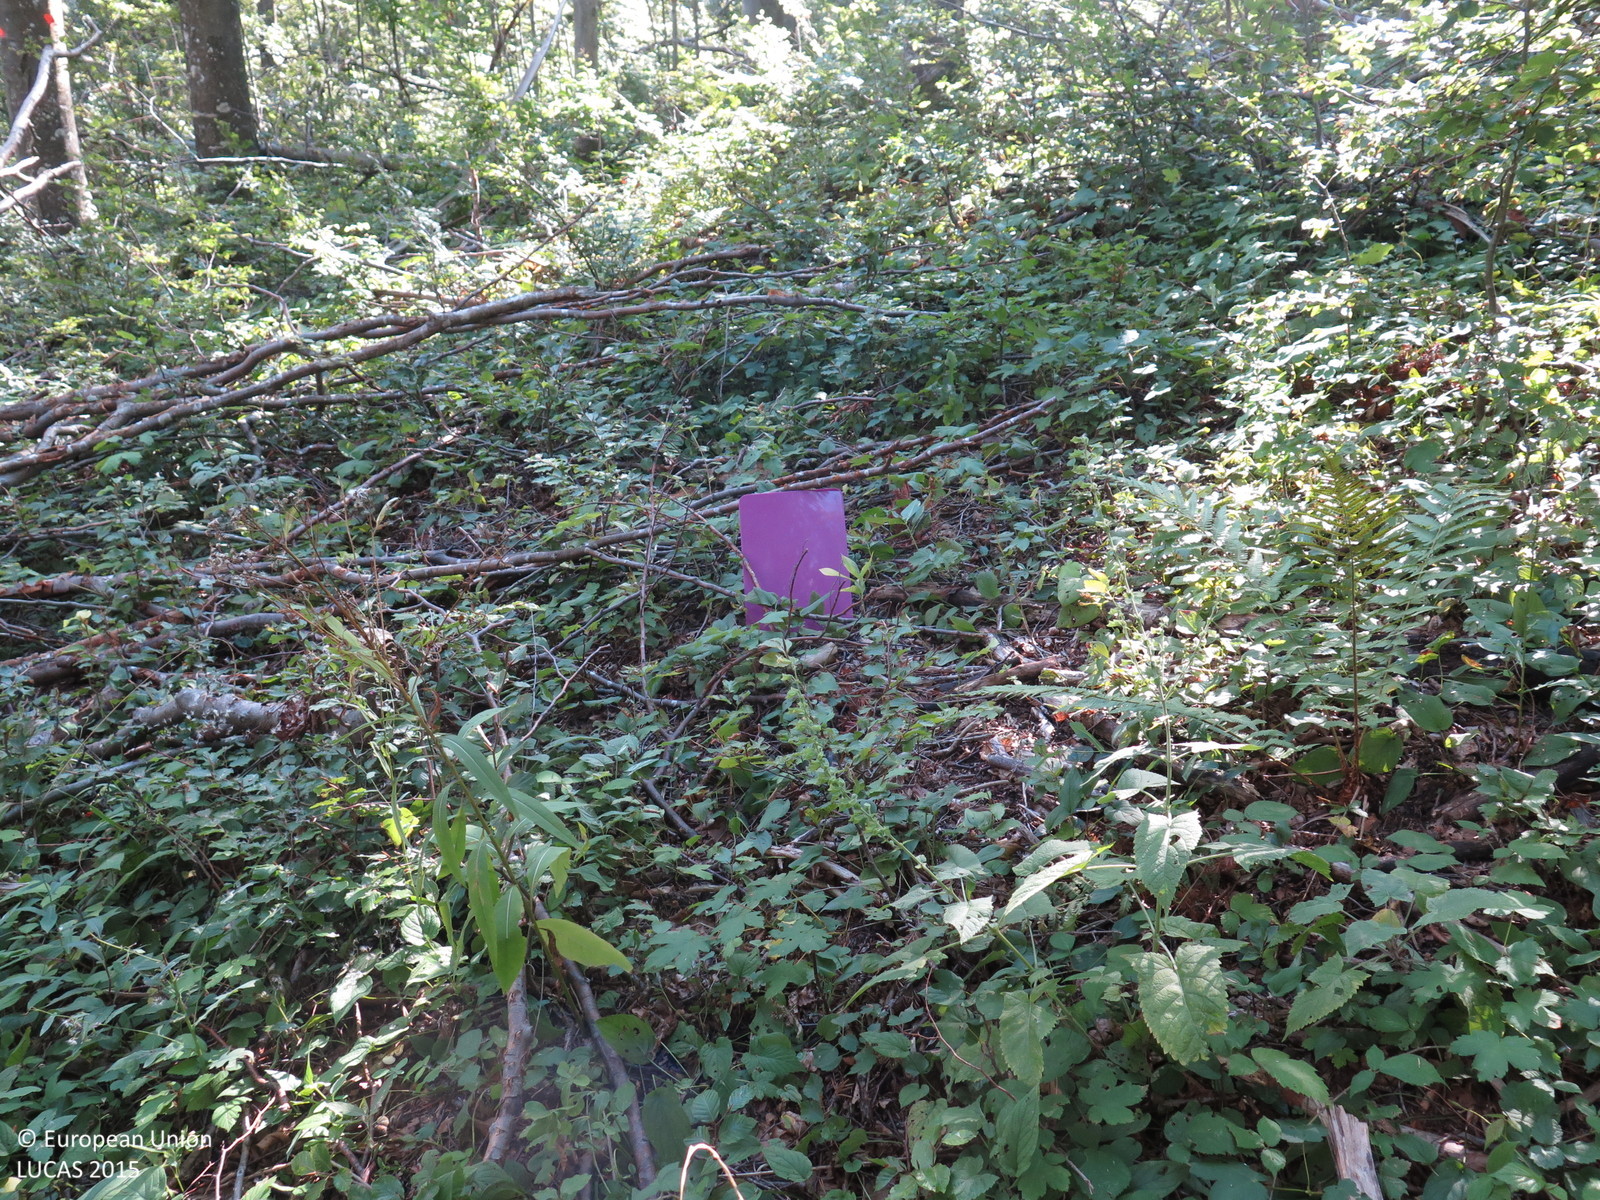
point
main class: Woodland
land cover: Other mixed woodland
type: alpine coniferous forest
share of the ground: > 75 %
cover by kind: coniferous forest trees 75 %, broadleaved forest trees 25 %
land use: Forestry
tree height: > 5 m
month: September
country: HR
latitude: 45.3982
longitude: 14.7346
